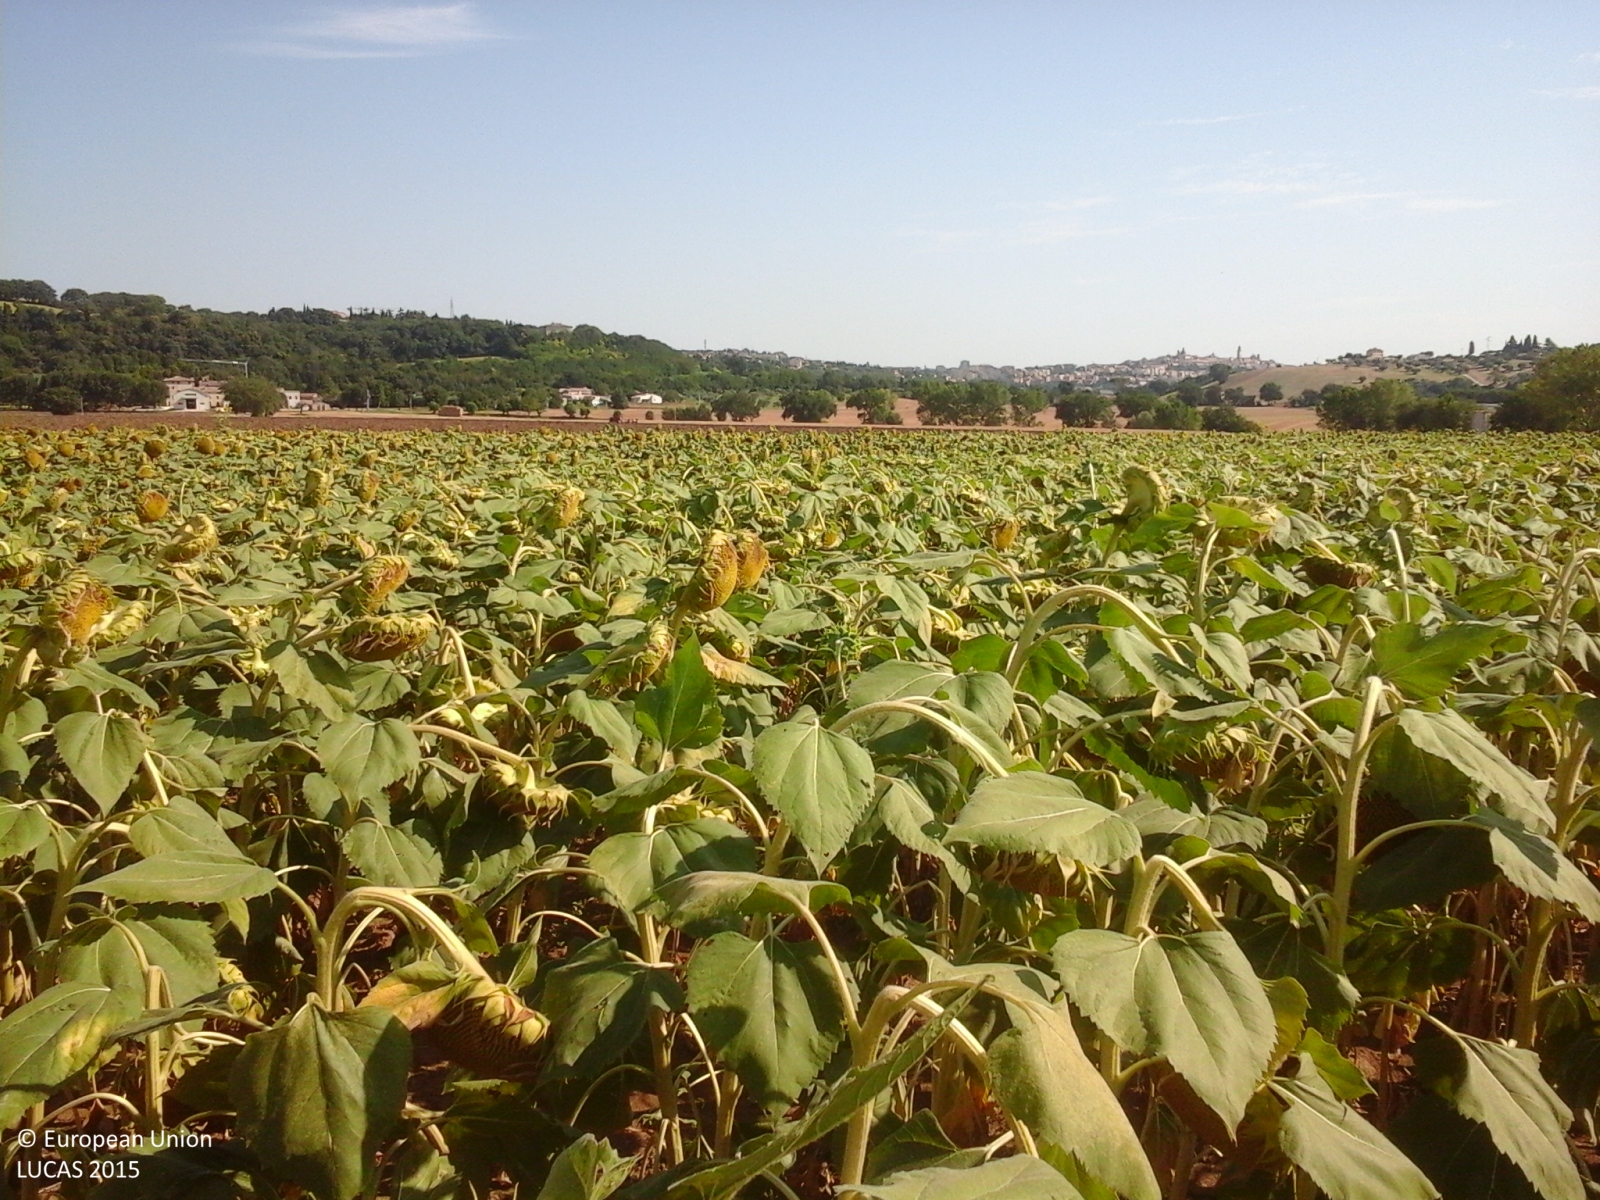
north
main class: Cropland
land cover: Sunflower
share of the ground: > 75 %
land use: Agriculture (excluding fallow land and kitchen gardens)
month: July
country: IT
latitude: 43.2646
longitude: 13.4283
